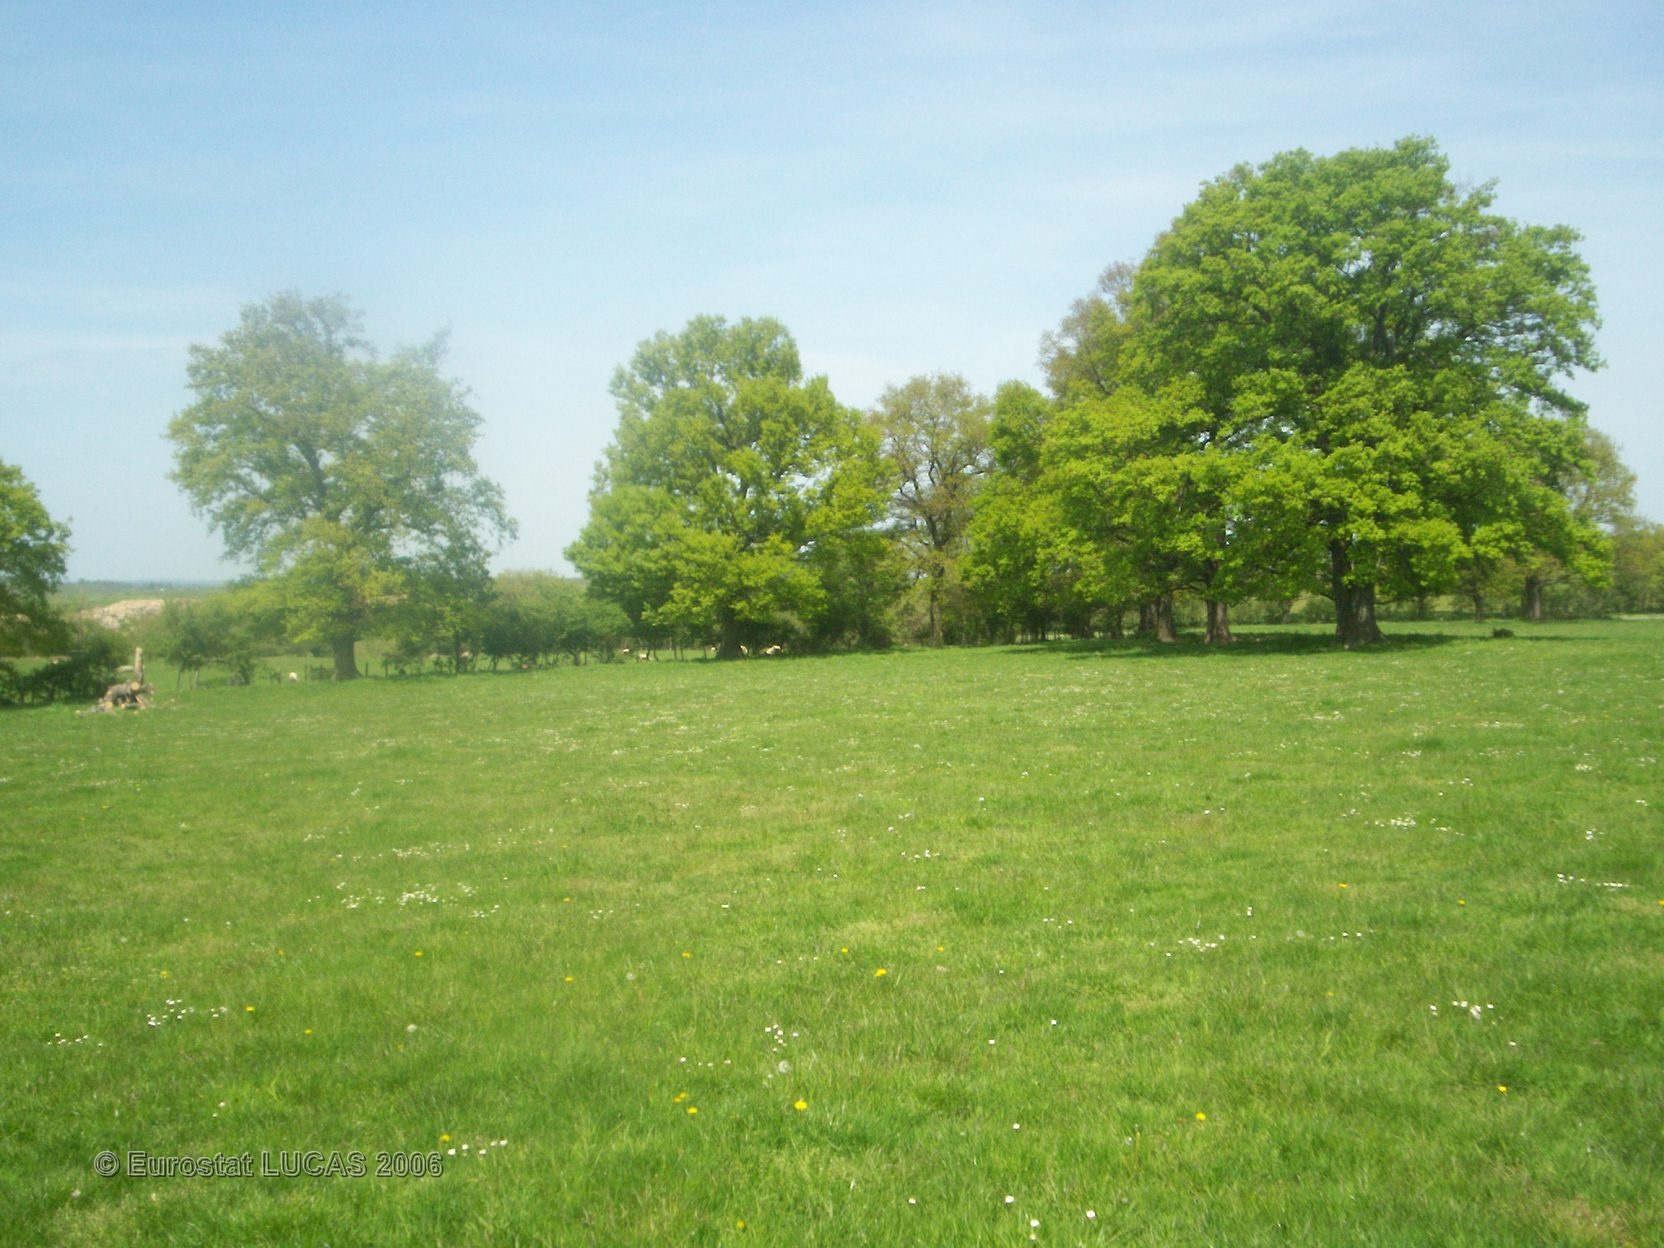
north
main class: Grassland
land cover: Grassland without tree/shrub cover
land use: Agriculture (excluding fallow land and kitchen gardens)
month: May
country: FR
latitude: 46.4935
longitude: 3.1577
